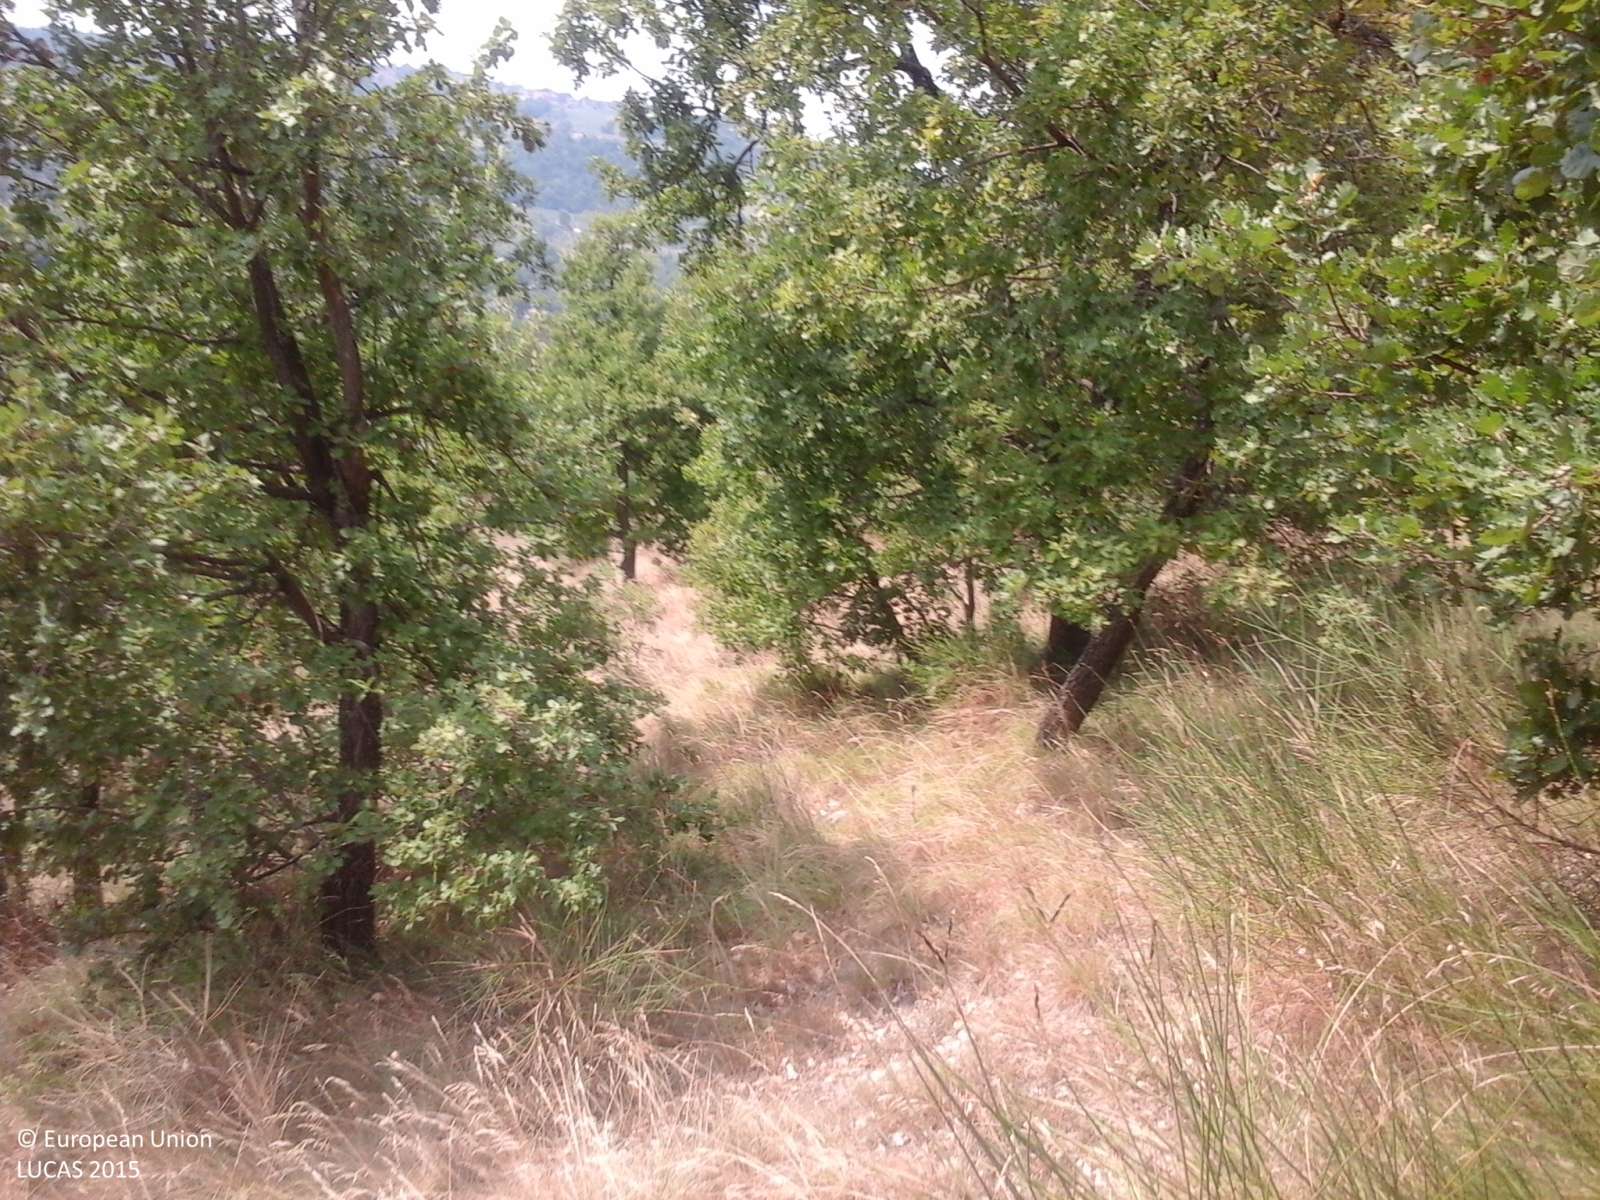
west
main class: Woodland
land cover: Broadleaved woodland
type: thermophilous deciduous forest
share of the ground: > 75 %
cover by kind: broadleaved forest trees 100 %
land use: Forestry
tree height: > 5 m
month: August
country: IT
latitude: 43.9055
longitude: 12.4967
